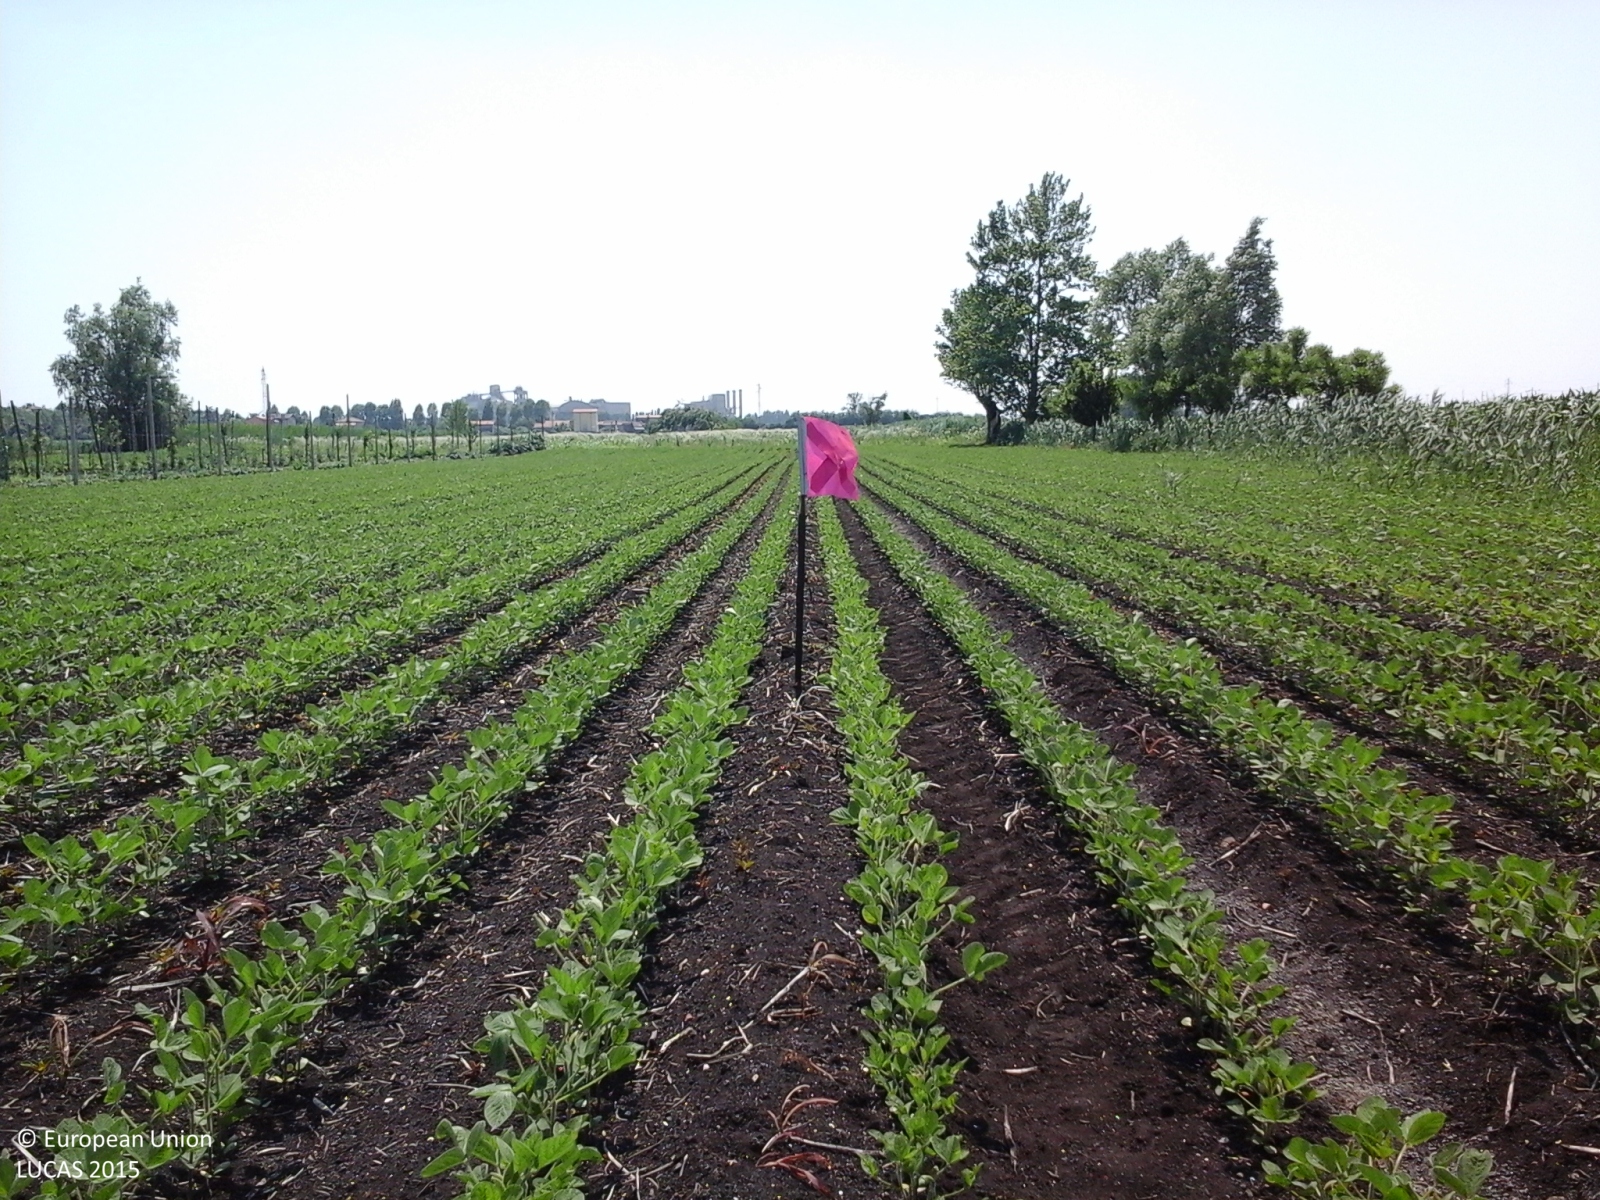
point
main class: Cropland
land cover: Soya
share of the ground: 25 - 50 %
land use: Agriculture (excluding fallow land and kitchen gardens)
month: June
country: IT
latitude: 45.2561
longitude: 11.7173
